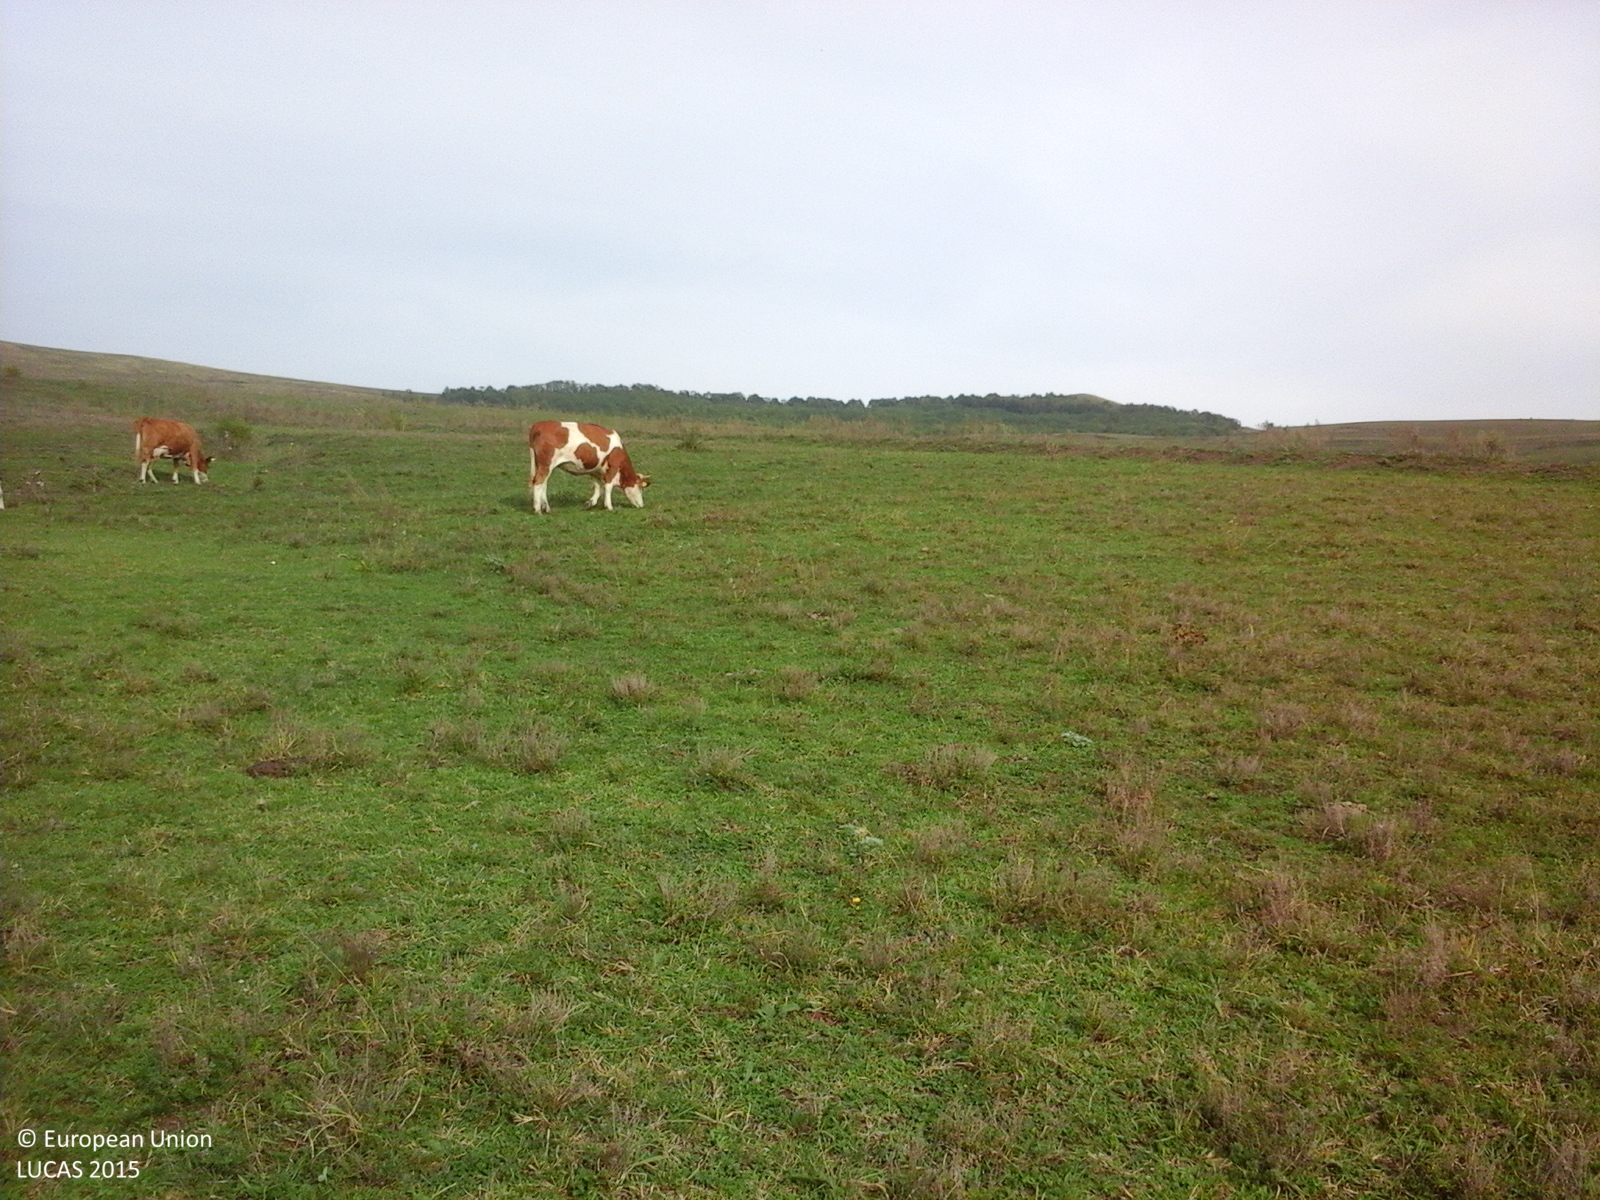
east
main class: Grassland
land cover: Grassland without tree/shrub cover
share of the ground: > 75 %
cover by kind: herbaceous plants 100 %
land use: Agriculture (excluding fallow land and kitchen gardens)
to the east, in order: Grassland without tree/shrub cover; Tracks; Grassland without tree/shrub cover
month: September
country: RO
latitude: 46.8126
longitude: 24.1439
